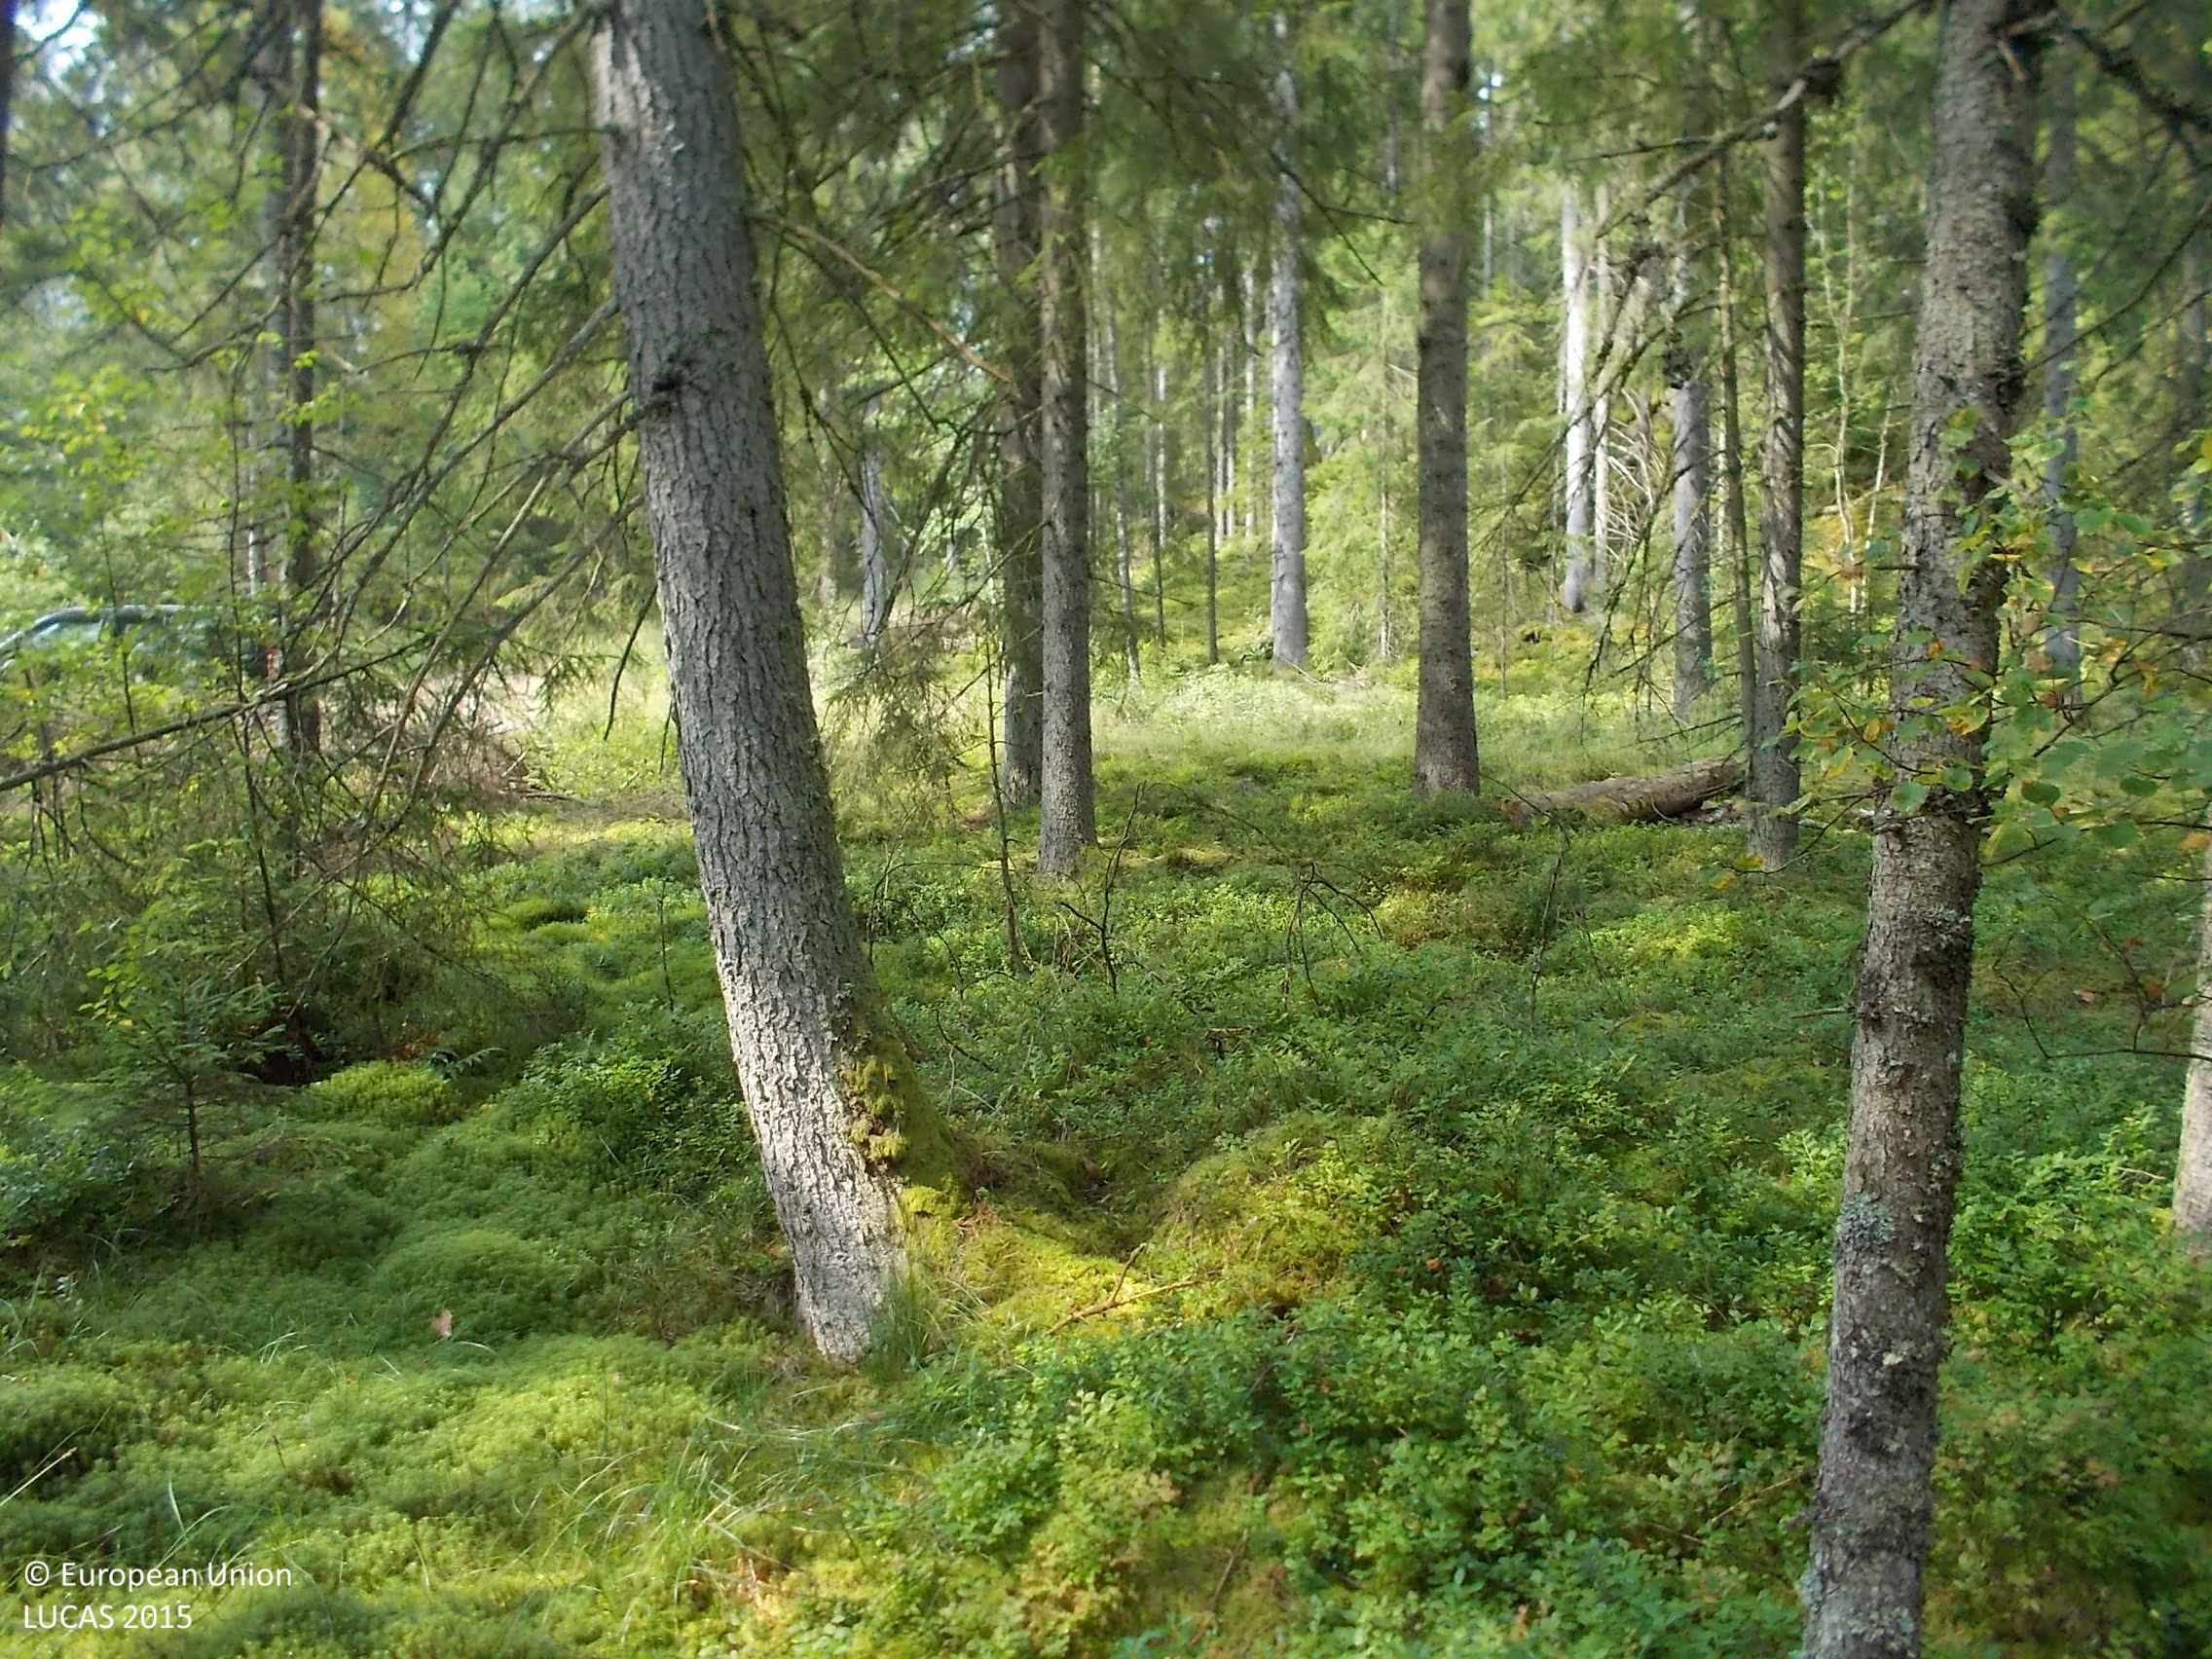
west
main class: Woodland
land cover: Spruce dominated coniferous woodland
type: boreal forest
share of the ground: > 75 %
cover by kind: coniferous forest trees 85 %, shrubs 10 %, lichens and mosses 5 %
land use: Forestry
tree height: > 5 m
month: August
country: SE
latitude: 57.3753
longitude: 13.0393
